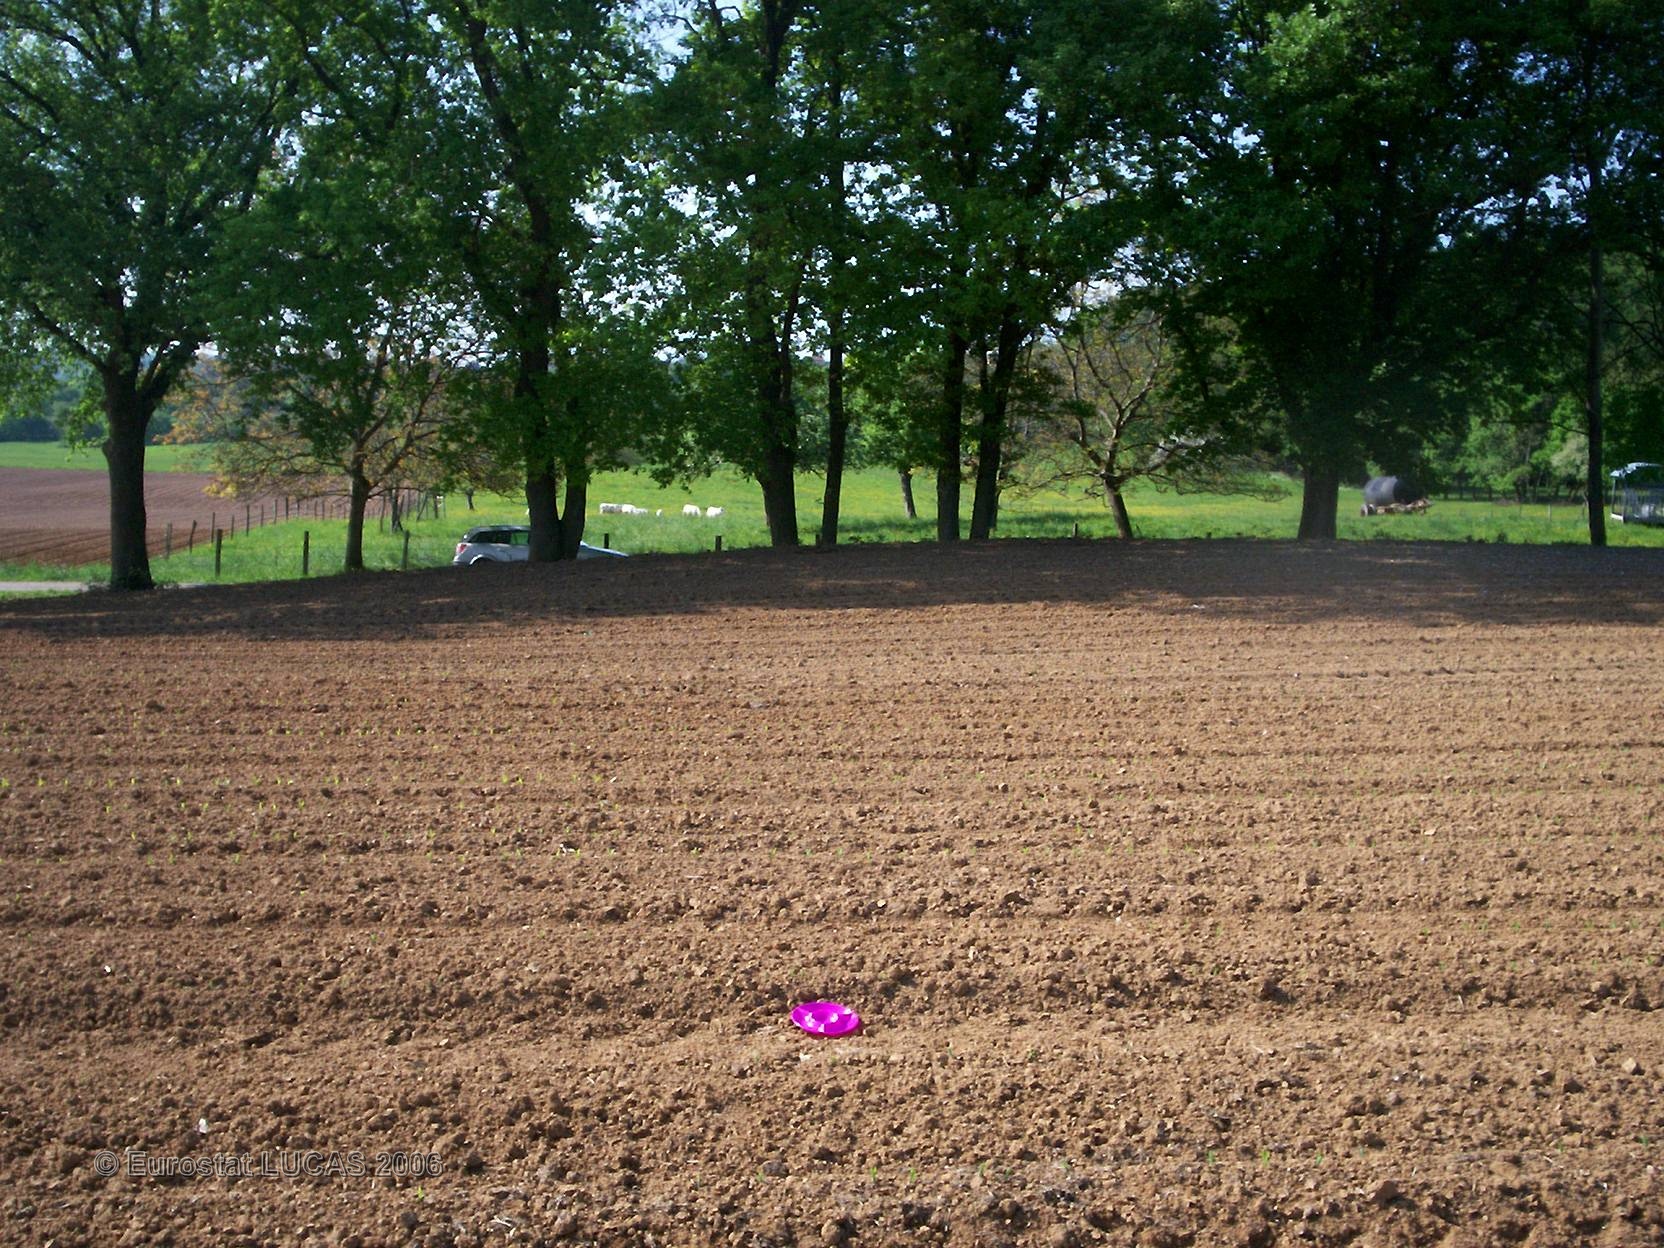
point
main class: Cropland
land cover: Maize
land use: Agriculture (excluding fallow land and kitchen gardens)
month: May
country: FR
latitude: 48.5526
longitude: 7.3861
